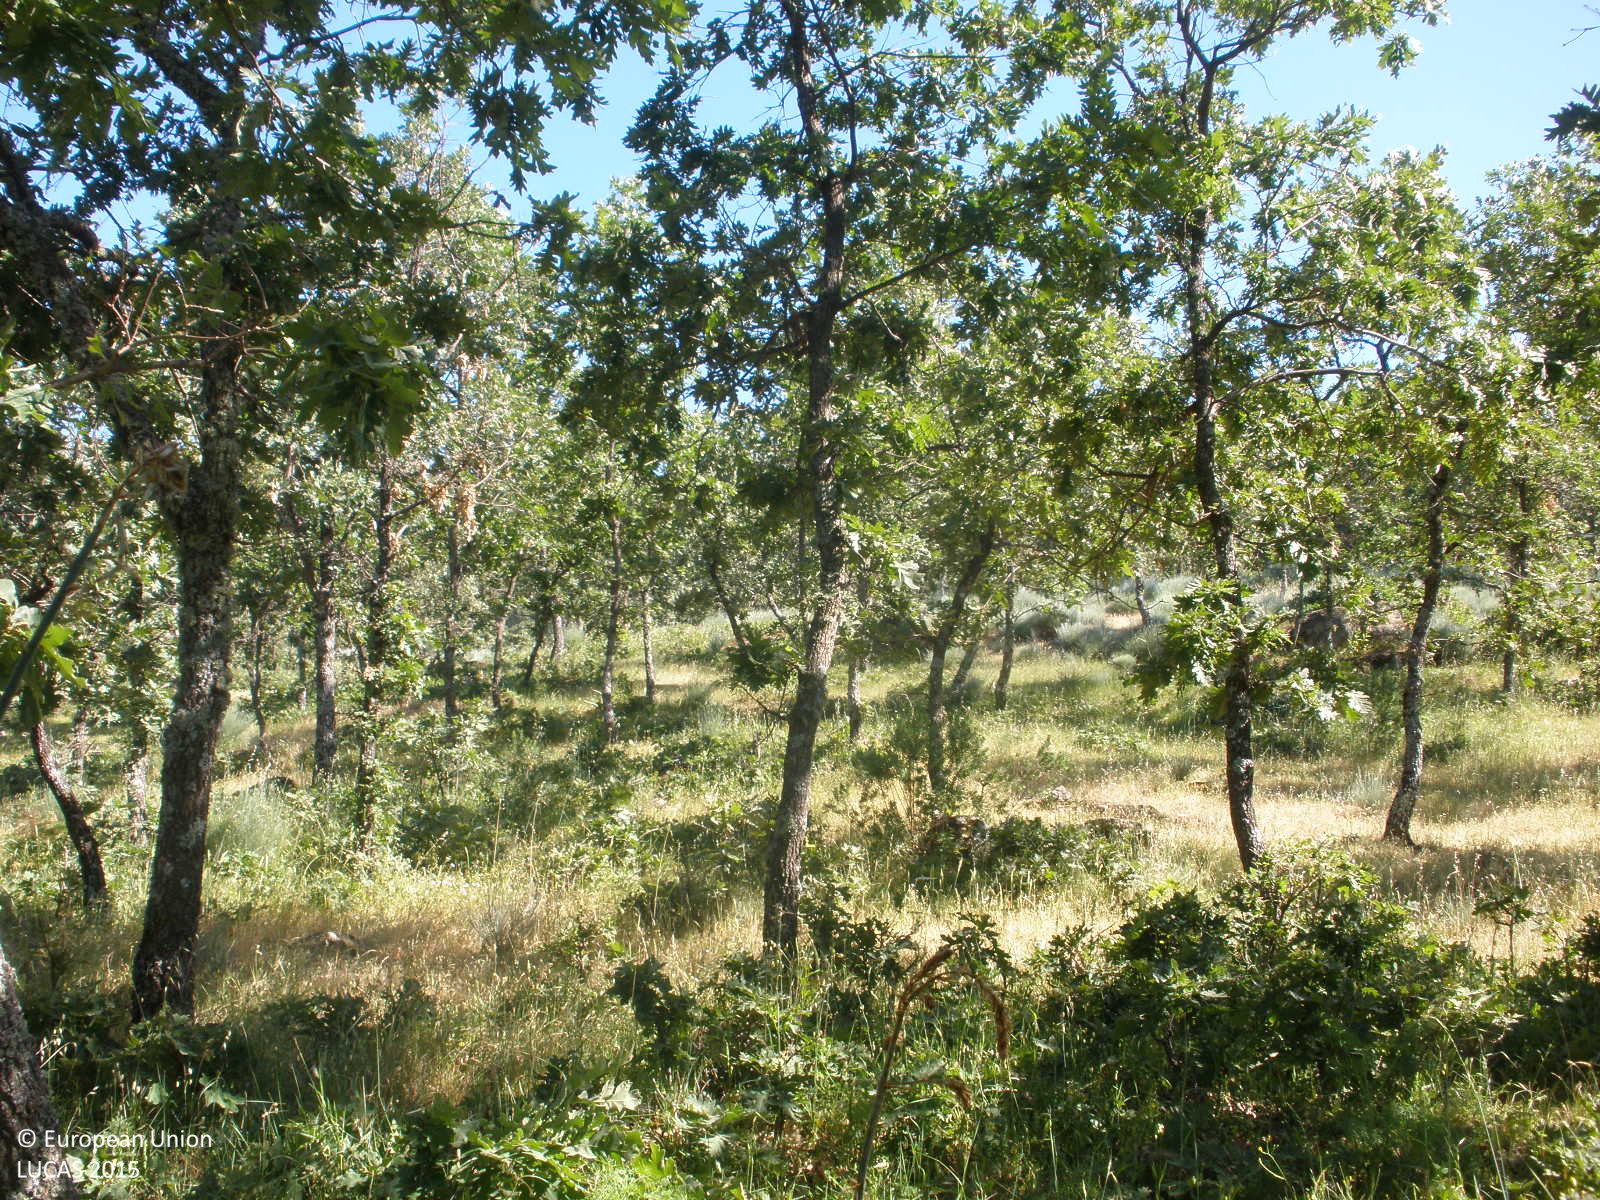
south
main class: Woodland
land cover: Broadleaved woodland
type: broadleaved evergreen forest
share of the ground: > 75 %
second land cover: Grassland without tree/shrub cover
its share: > 75 %
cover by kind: broadleaved forest trees 80 %, herbaceous plants 20 %
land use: Forestry
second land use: Agriculture (excluding fallow land and kitchen gardens)
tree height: > 5 m
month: May
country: ES
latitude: 40.1358
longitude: -6.7891
